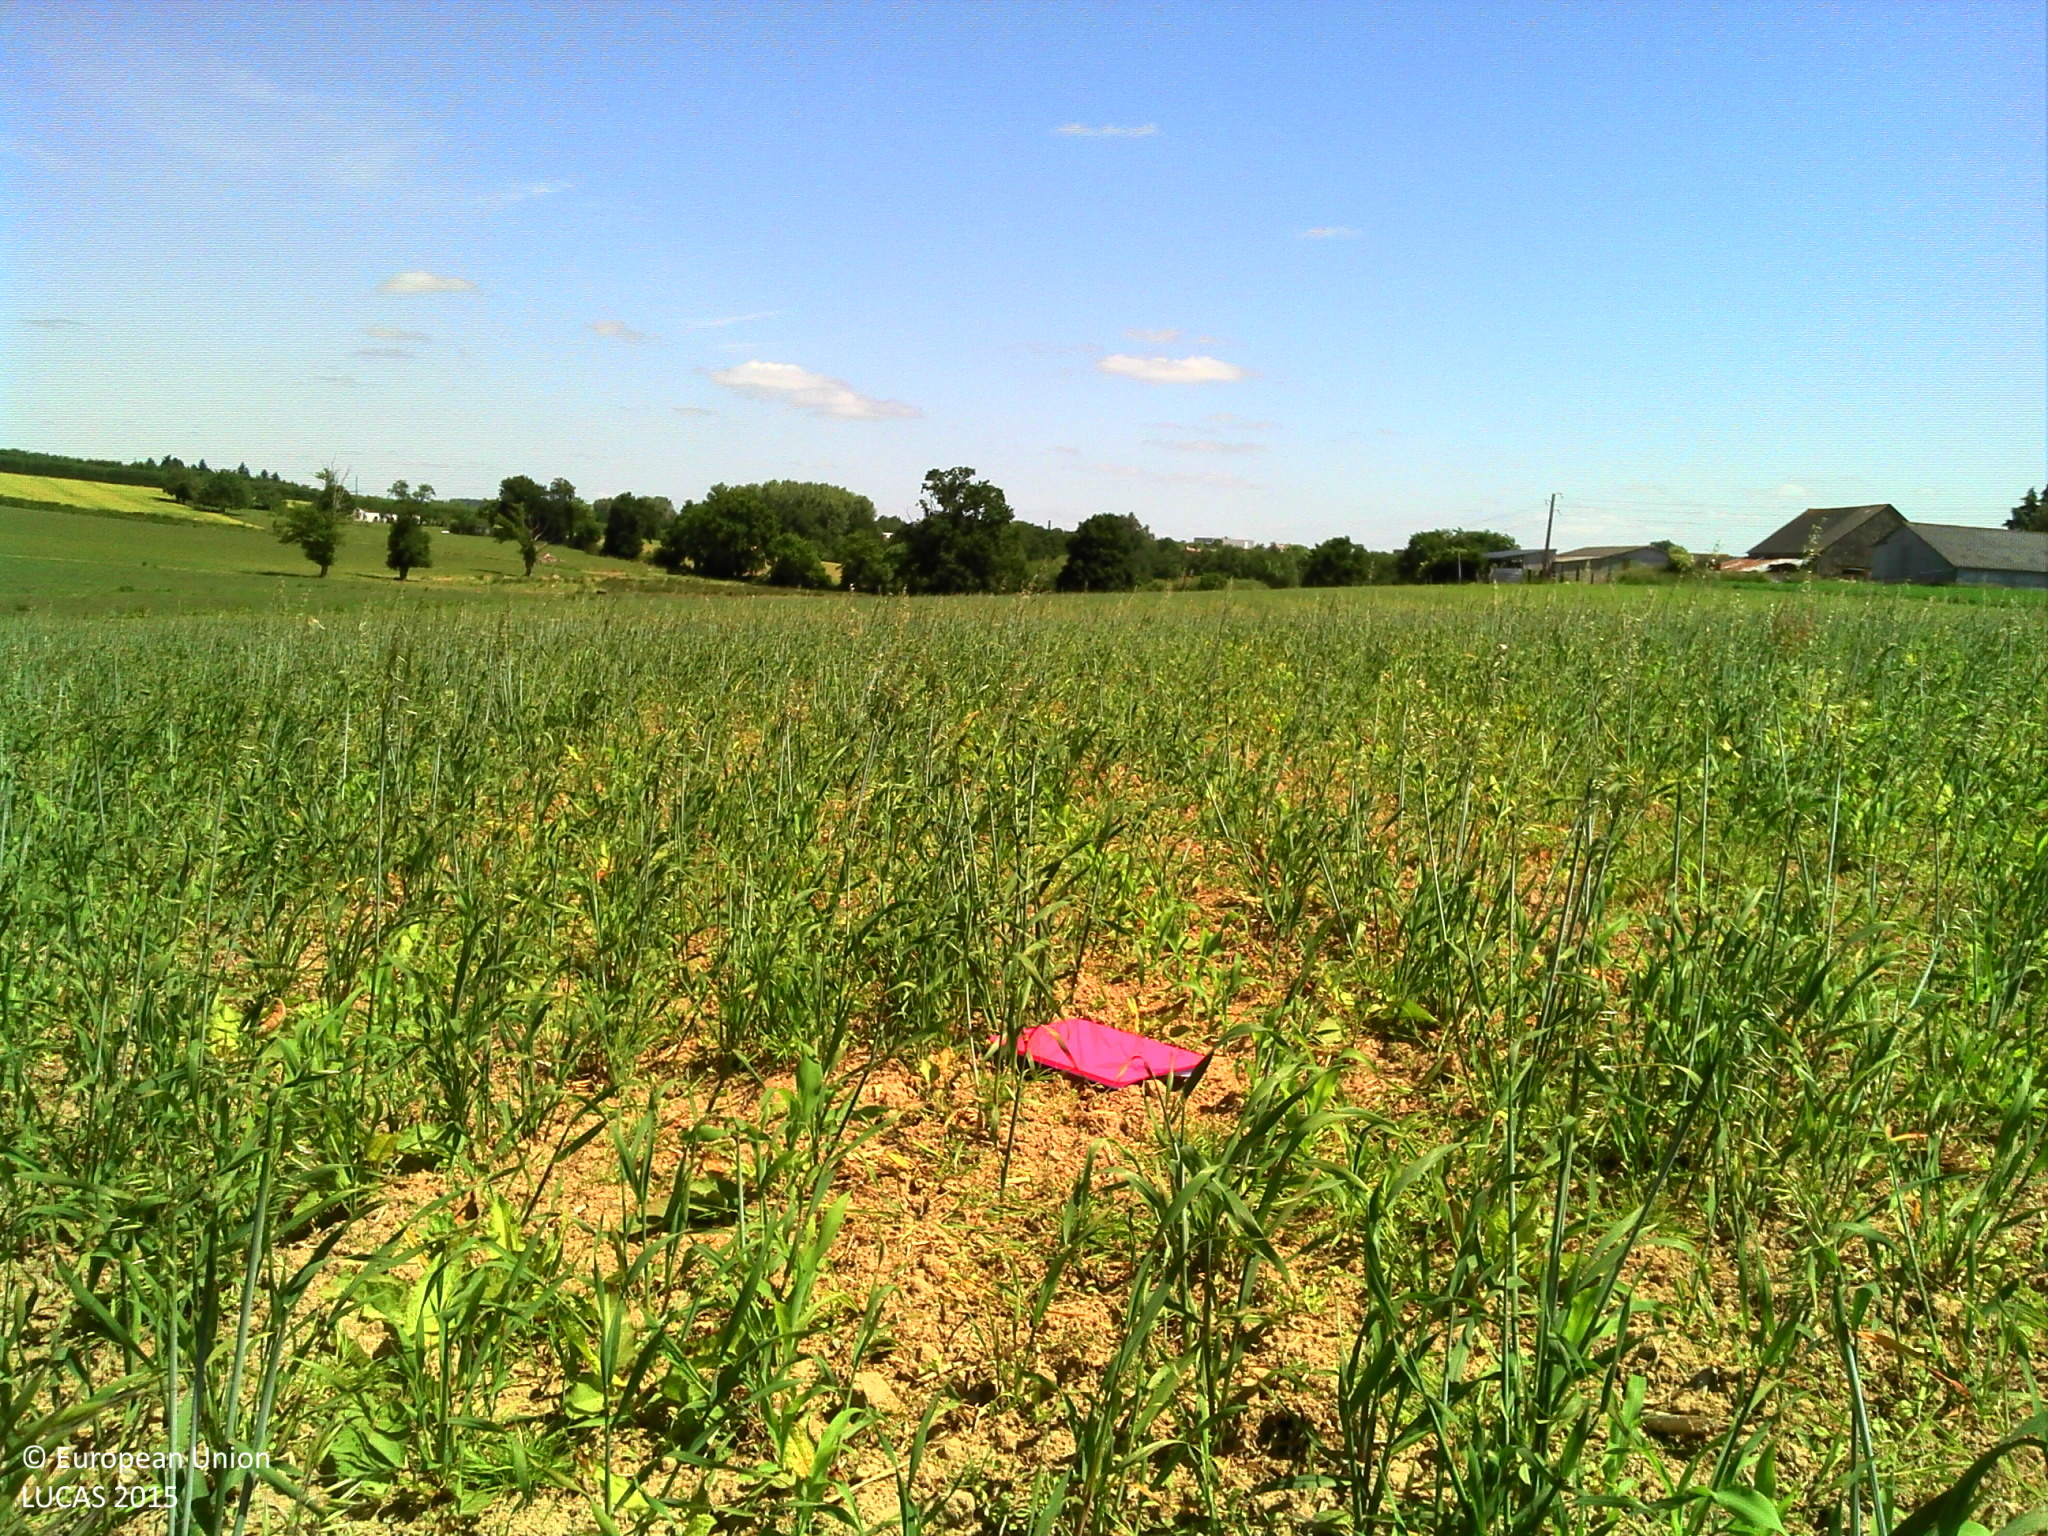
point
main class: Cropland
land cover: Maize
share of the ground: > 75 %
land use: Agriculture (excluding fallow land and kitchen gardens)
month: June
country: FR
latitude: 48.0950
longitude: -1.4717
